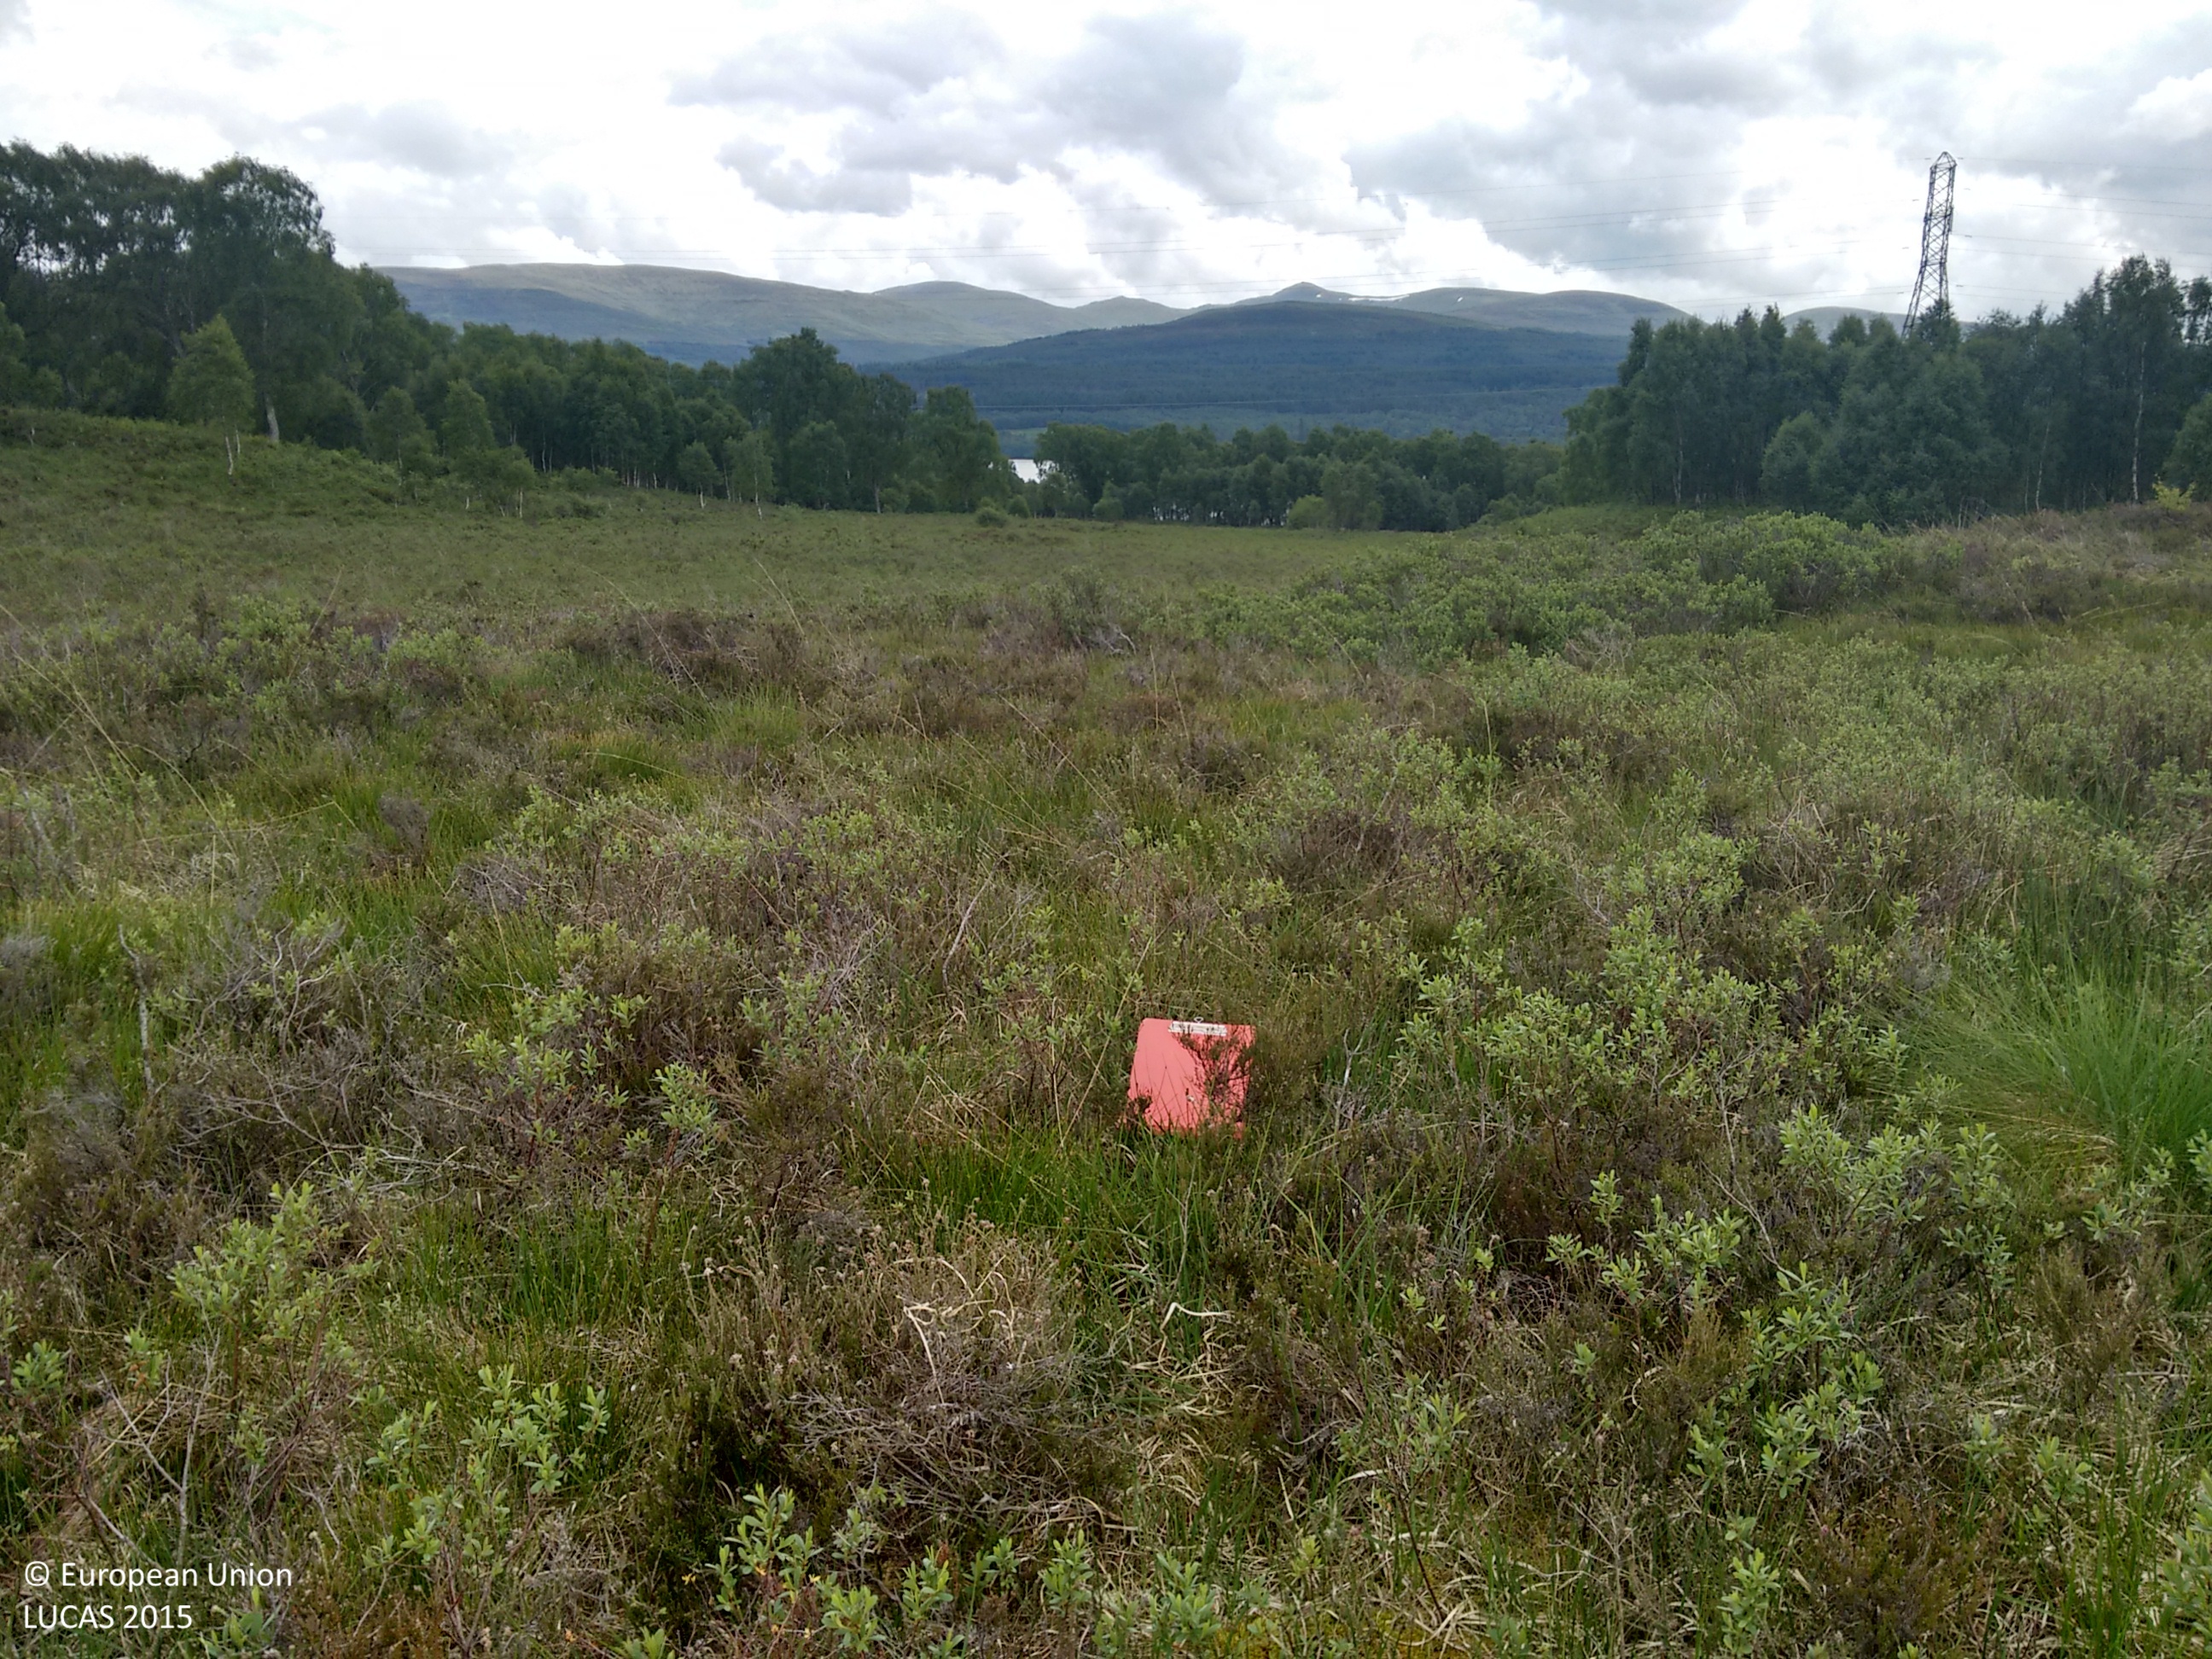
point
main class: Shrubland
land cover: Shrubland without tree cover
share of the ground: > 75 %
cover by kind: shrubs 65 %, herbaceous plants 25 %, lichens and mosses 10 %
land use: Semi-natural and natural areas not in use
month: July
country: GB
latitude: 56.6969
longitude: -4.3145
